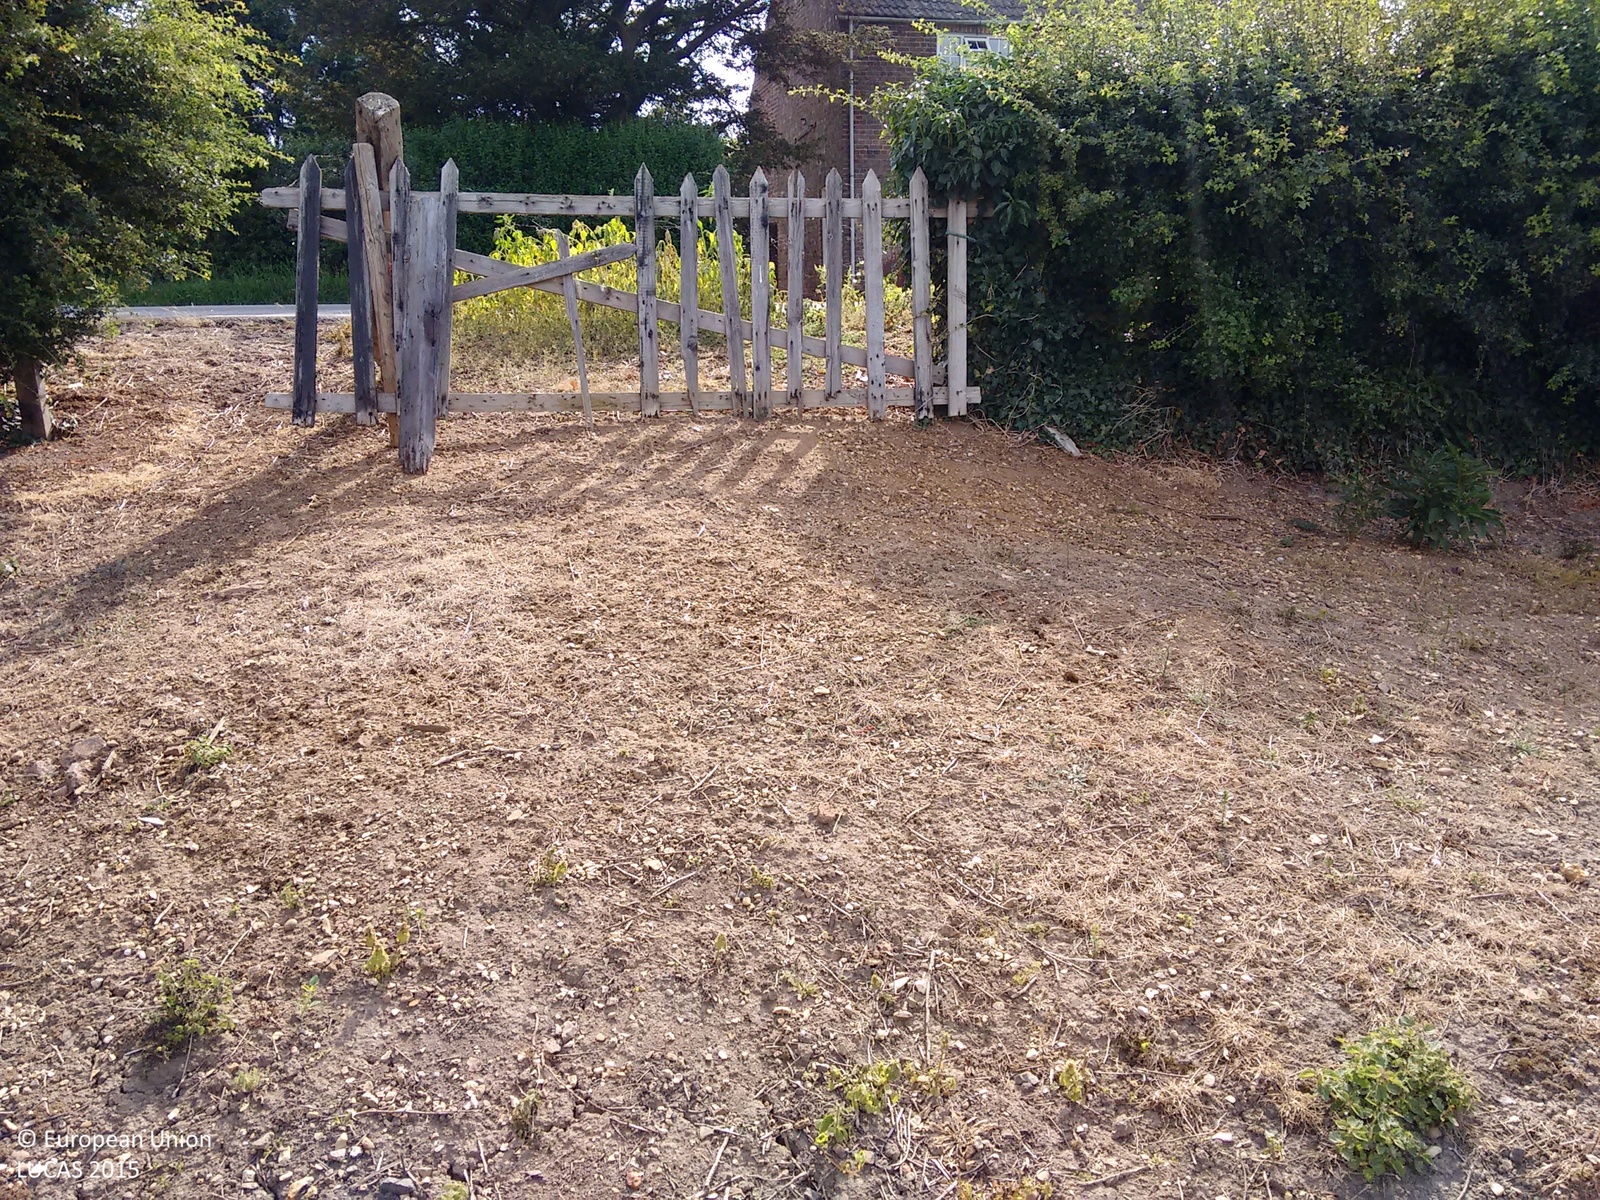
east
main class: Cropland
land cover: Arable land (only in case pi)
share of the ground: > 75 %
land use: Agriculture (excluding fallow land and kitchen gardens)
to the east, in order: Arable land (only in case pi); Grass margins; Arable land (only in case pi); Grass margins; Ditches and canals; Grass margins; Arable land (only in case pi)
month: July
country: GB
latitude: 52.6623
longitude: 0.0172
